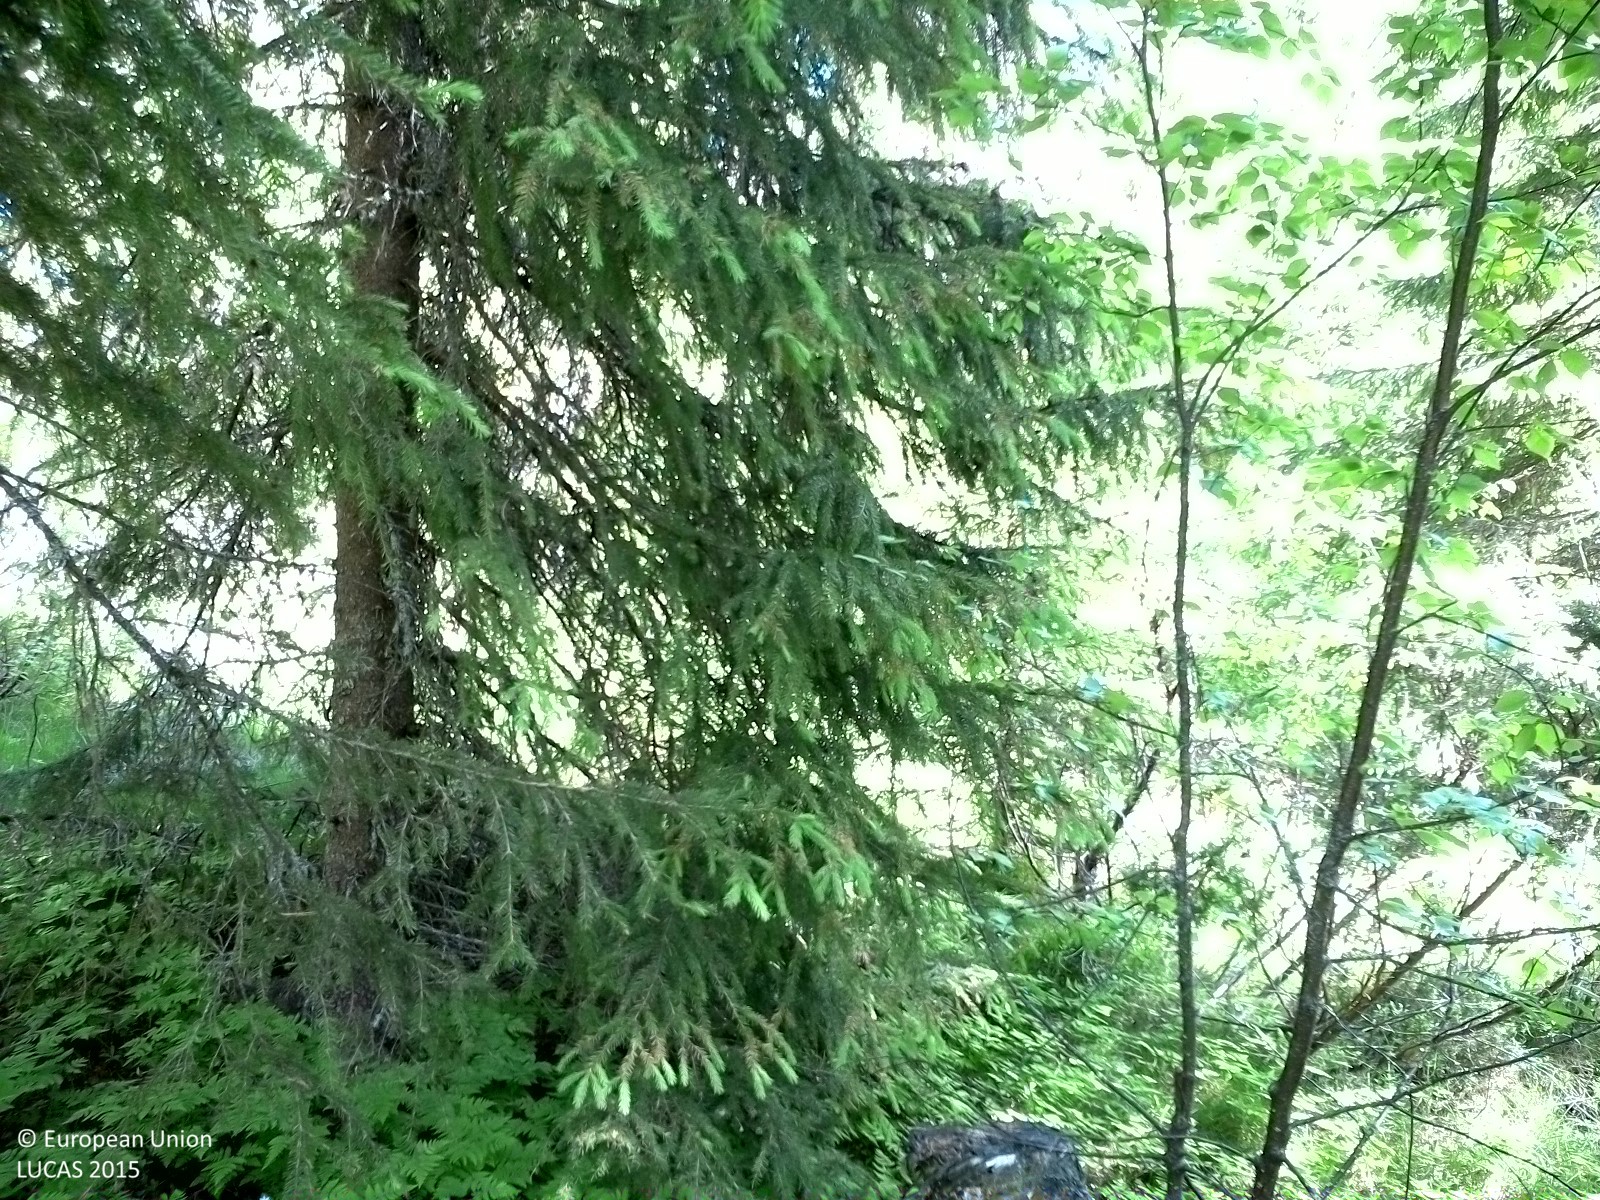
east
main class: Woodland
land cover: Other mixed woodland
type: boreal forest
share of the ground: 25 - 50 %
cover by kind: broadleaved forest trees 30 %, herbaceous plants 30 %, coniferous forest trees 20 %, lichens and mosses 20 %
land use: Forestry
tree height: > 5 m
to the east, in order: Other mixed woodland; Spruce dominated mixed woodland; Ditches and canals; Paved roads, cycling and walking lanes; Ditches and canals; Grass margins; Spruce dominated mixed woodland; Other mixed woodland; Spruce dominated coniferous woodland
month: July
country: SE
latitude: 62.1530
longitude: 16.7552
